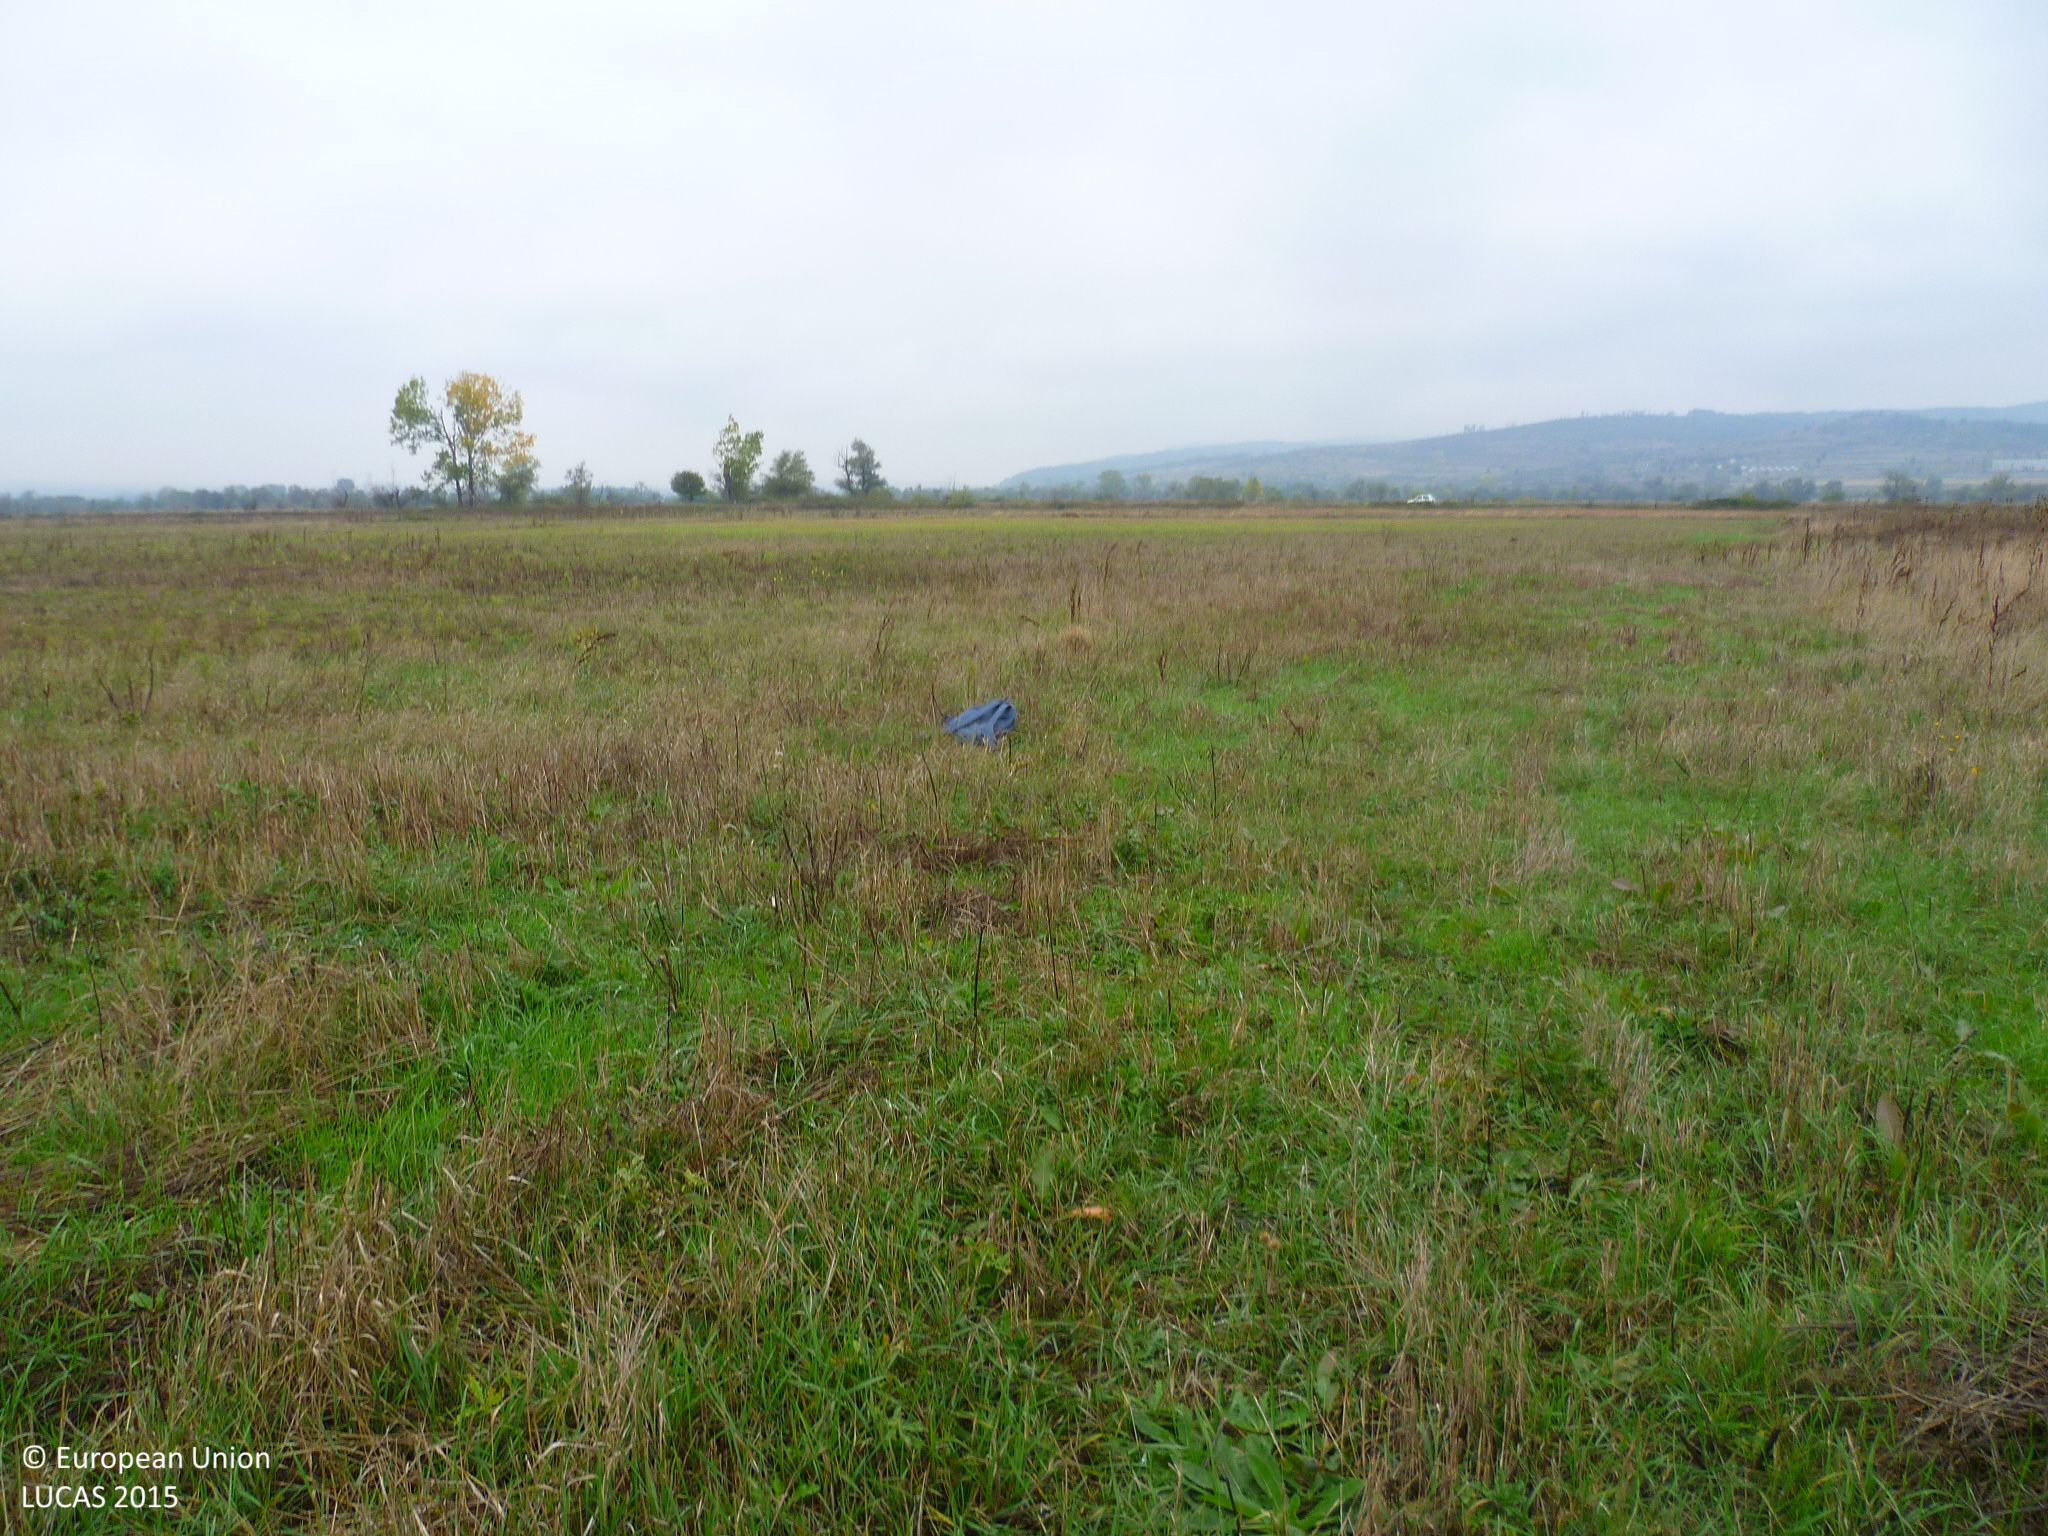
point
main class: Grassland
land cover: Grassland without tree/shrub cover
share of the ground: > 75 %
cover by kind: herbaceous plants 100 %
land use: Agriculture (excluding fallow land and kitchen gardens)
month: October
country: BG
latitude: 42.3248
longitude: 23.8107
